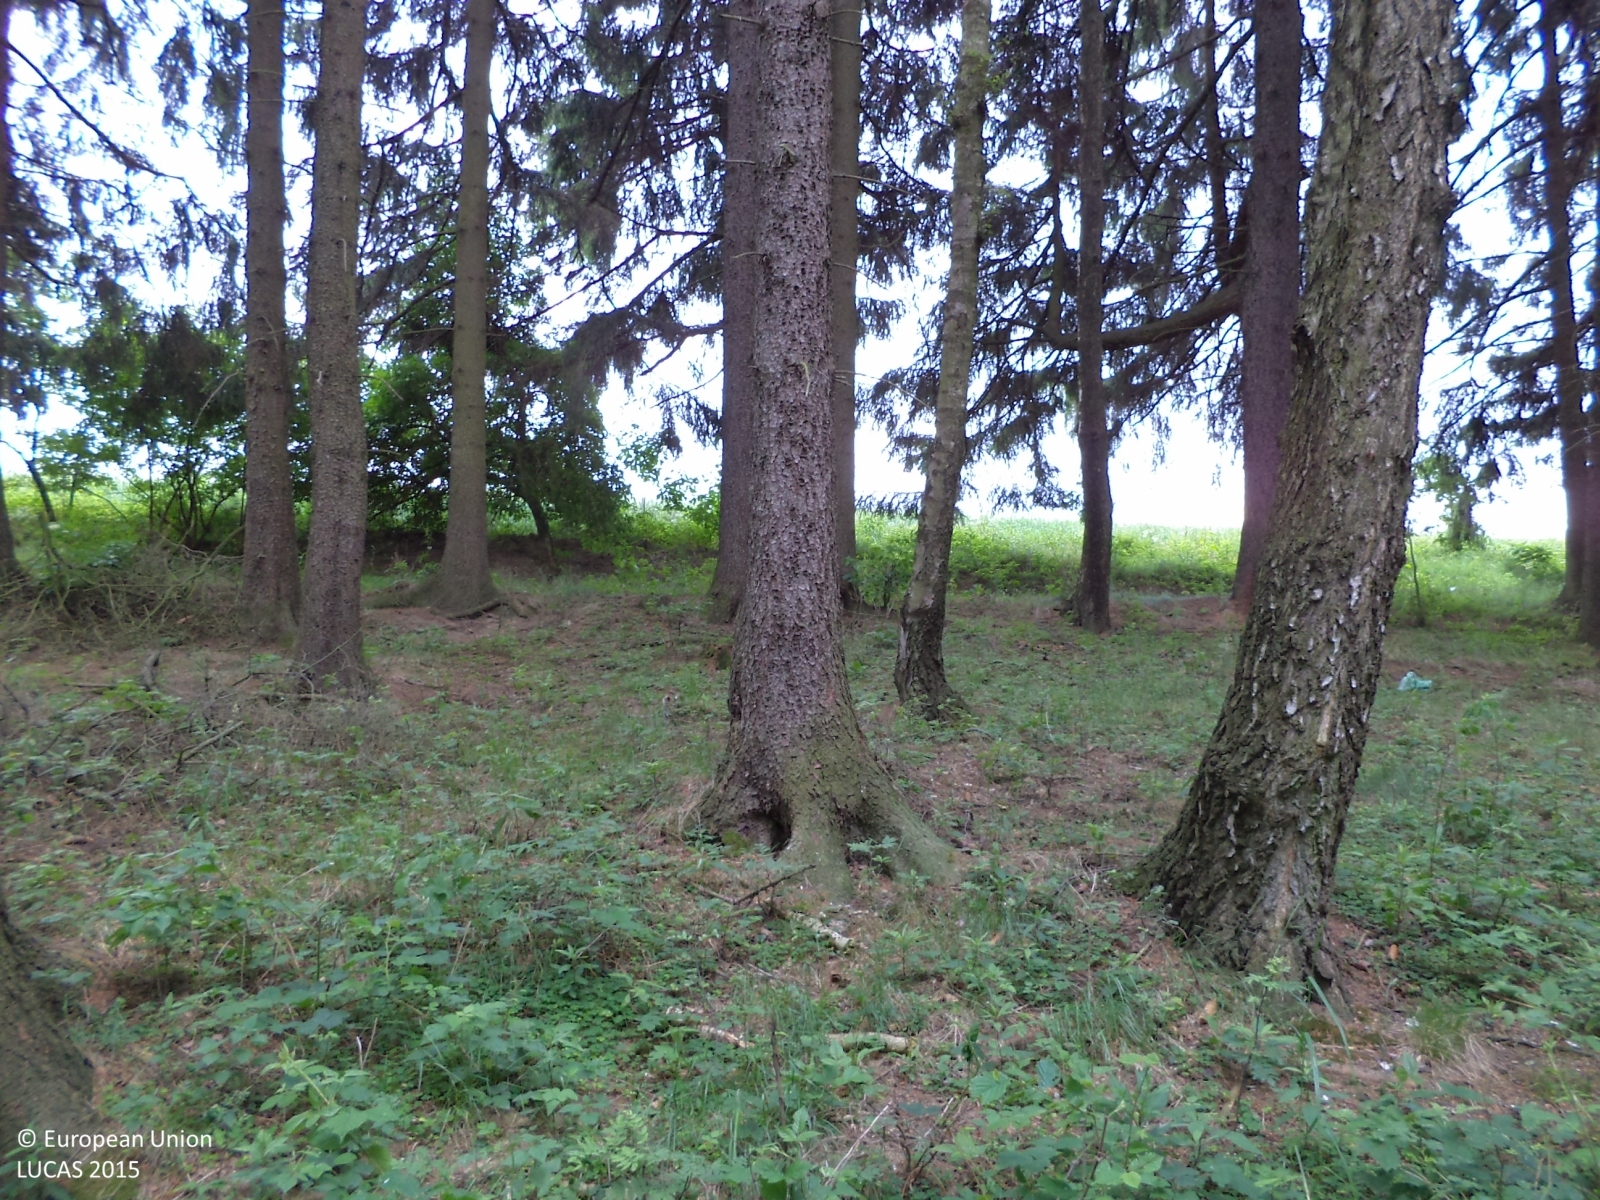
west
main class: Woodland
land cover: Spruce dominated coniferous woodland
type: hemiboreal forest and nemoral coniferous forest and mixed broadleaved-coniferous forest
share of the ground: > 75 %
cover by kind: coniferous forest trees 90 %, shrubs 5 %, herbaceous plants 5 %
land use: Forestry
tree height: > 5 m
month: June
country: CZ
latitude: 49.5728
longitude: 14.9392
